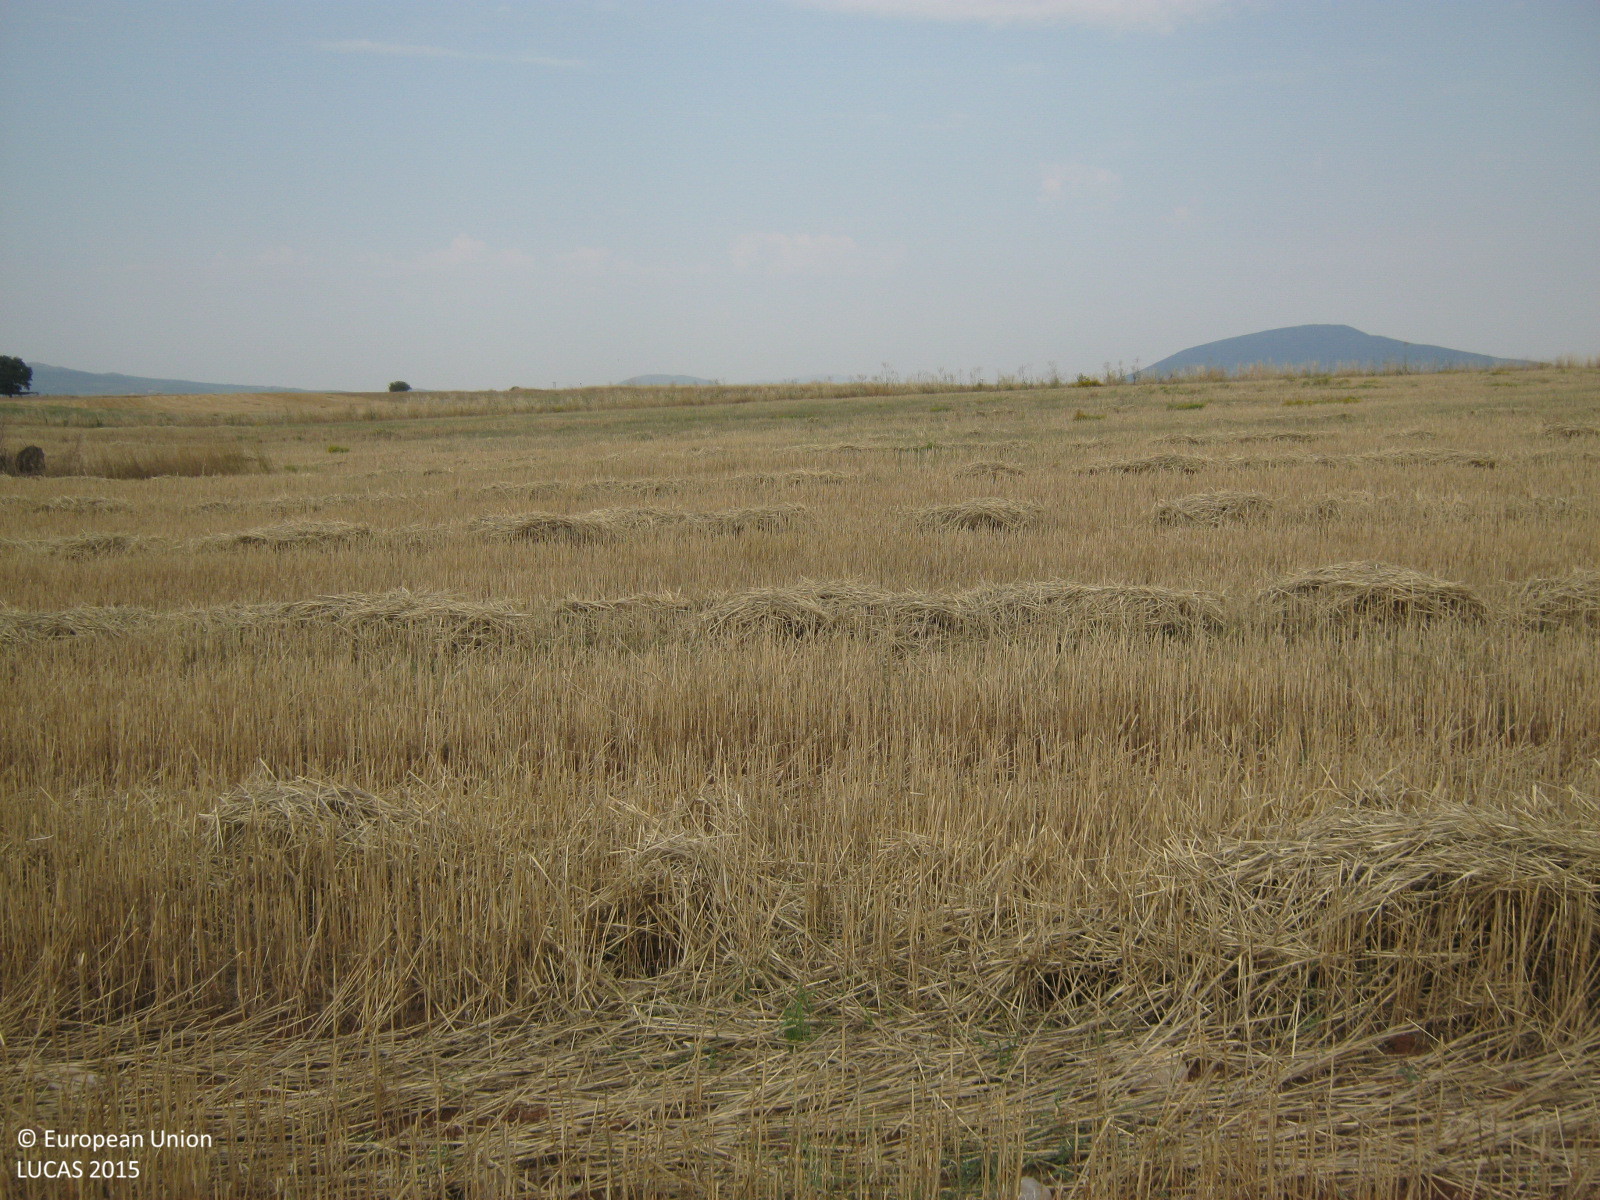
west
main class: Cropland
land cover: Durum wheat
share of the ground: < 10 %
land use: Agriculture (excluding fallow land and kitchen gardens)
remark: Harvested field
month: July
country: GR
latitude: 39.2019
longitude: 22.6898
